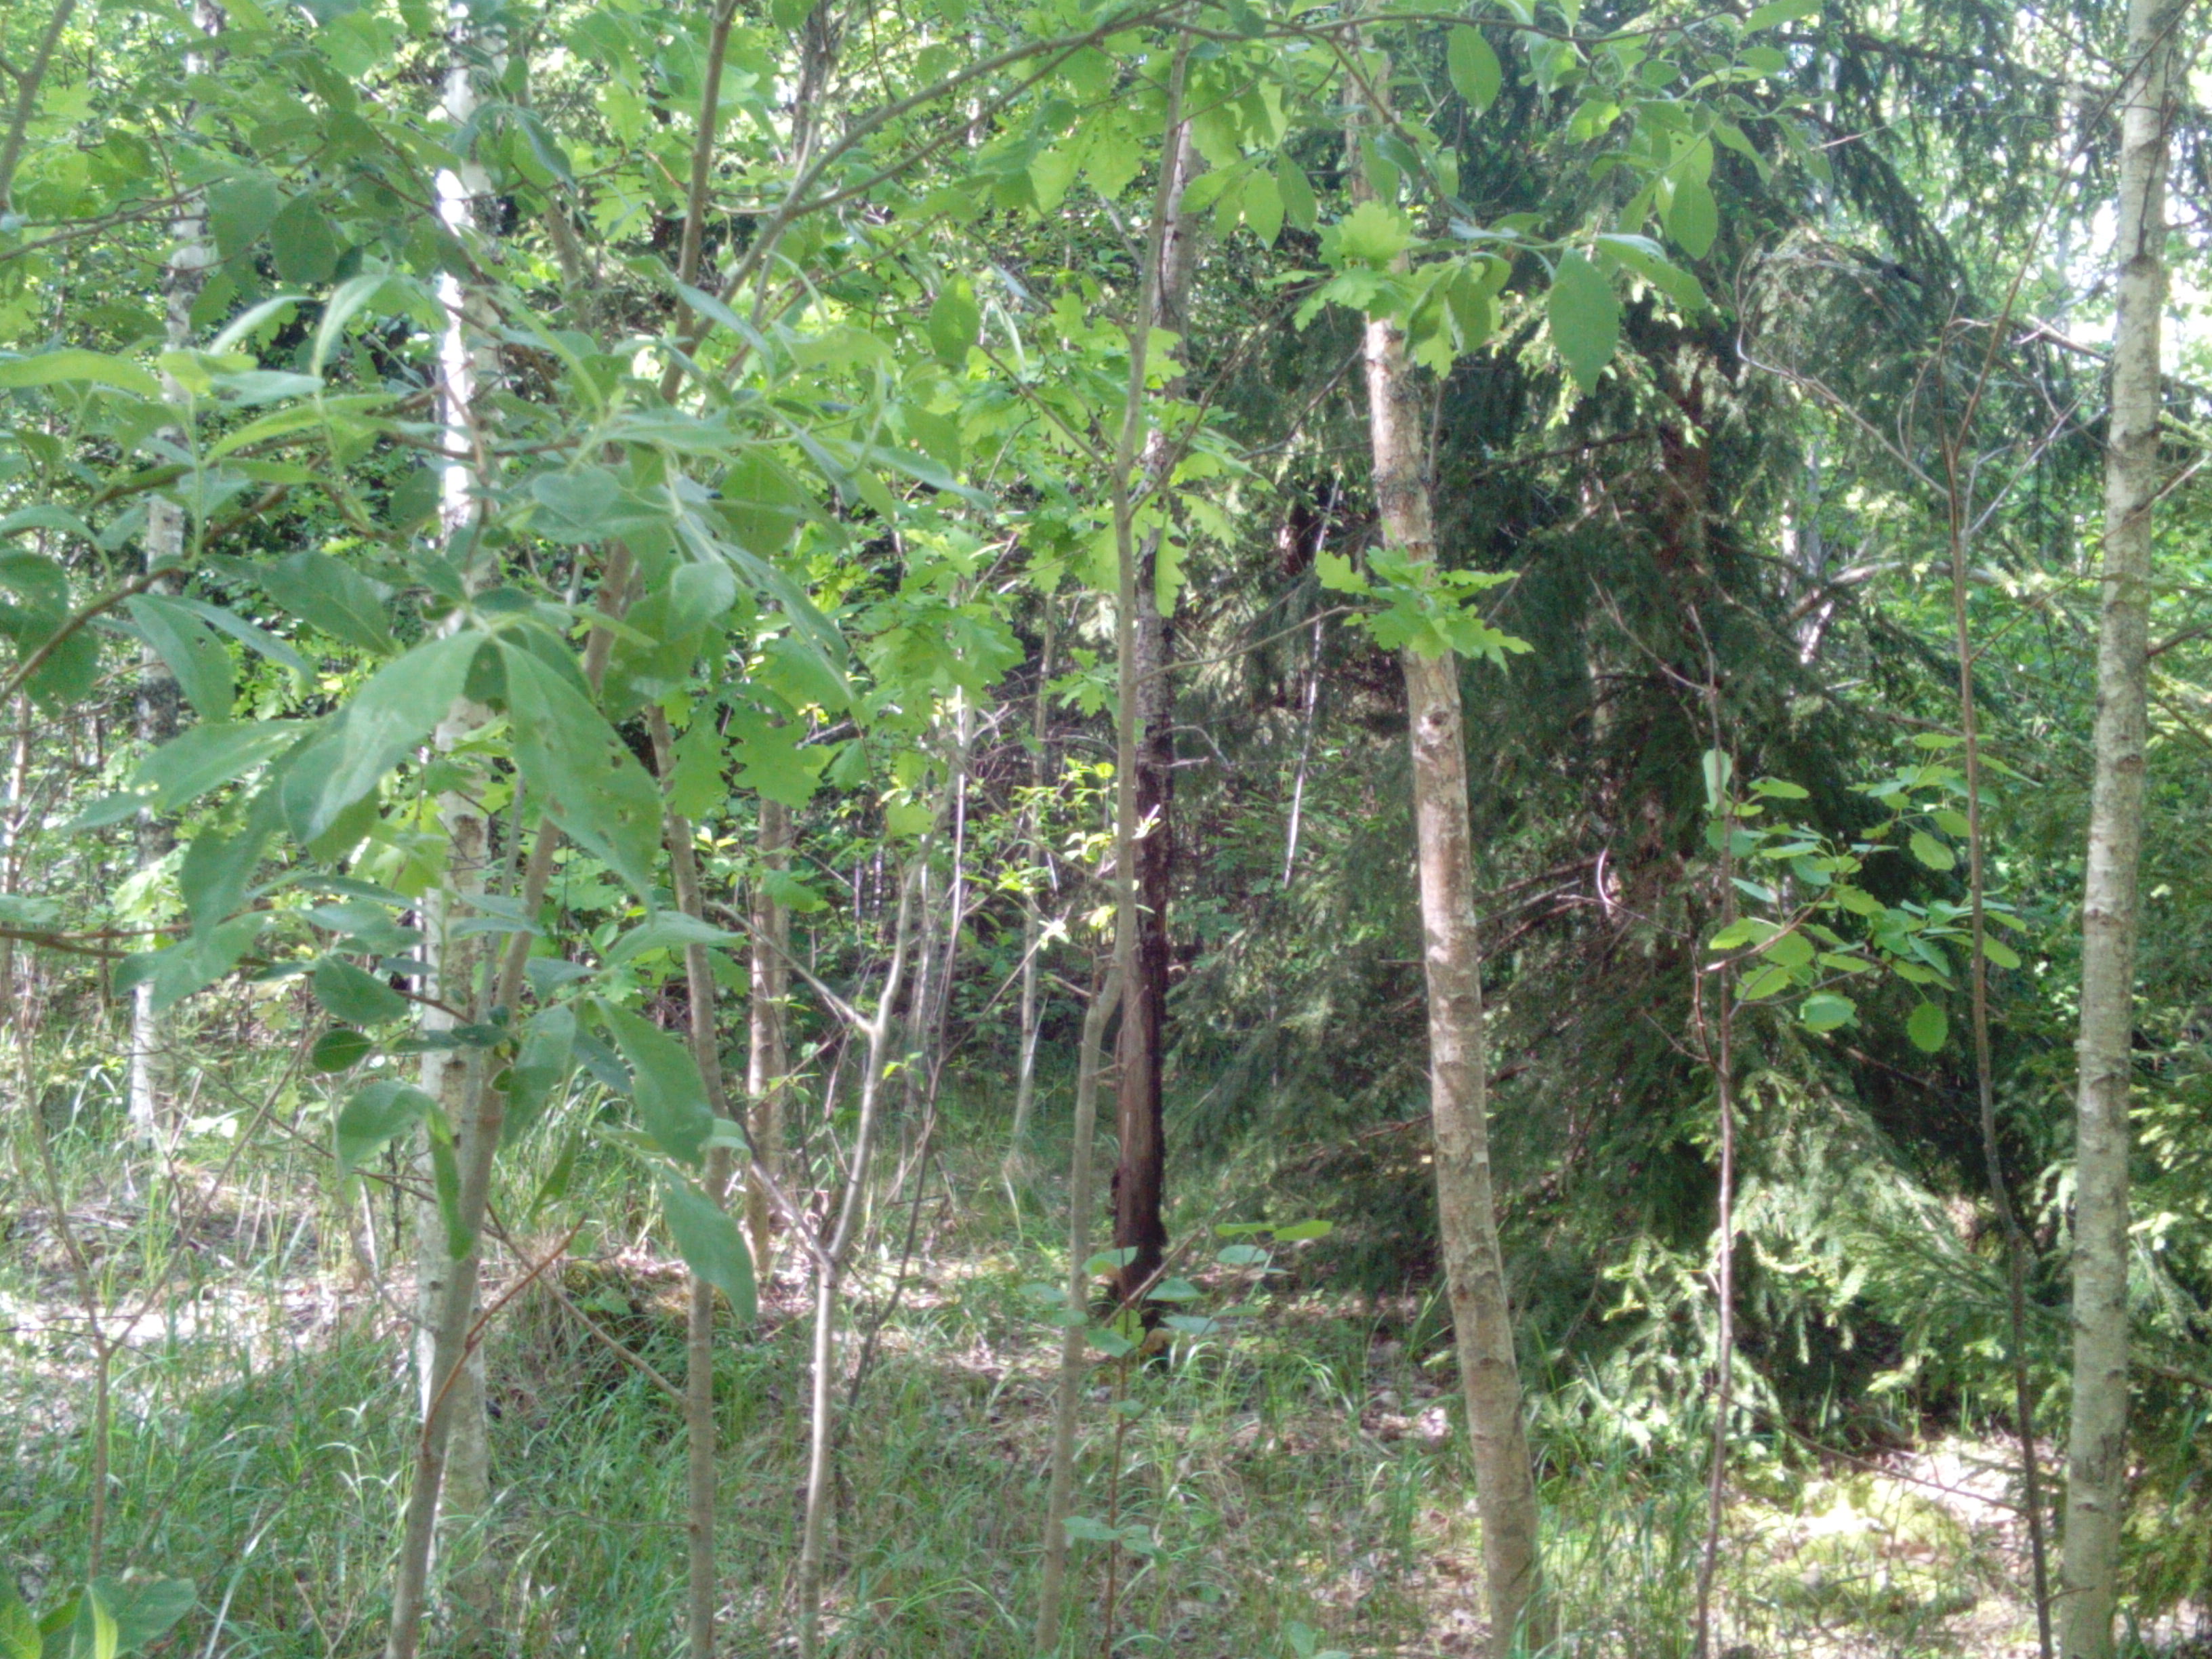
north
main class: Woodland
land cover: Broadleaved woodland
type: acidophilous oak and oak-birch forest
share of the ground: > 75 %
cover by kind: broadleaved forest trees 80 %, coniferous forest trees 15 %, herbaceous plants 5 %
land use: Forestry
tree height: > 5 m
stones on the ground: < 10 %
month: June
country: LV
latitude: 56.7086
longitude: 22.2548
